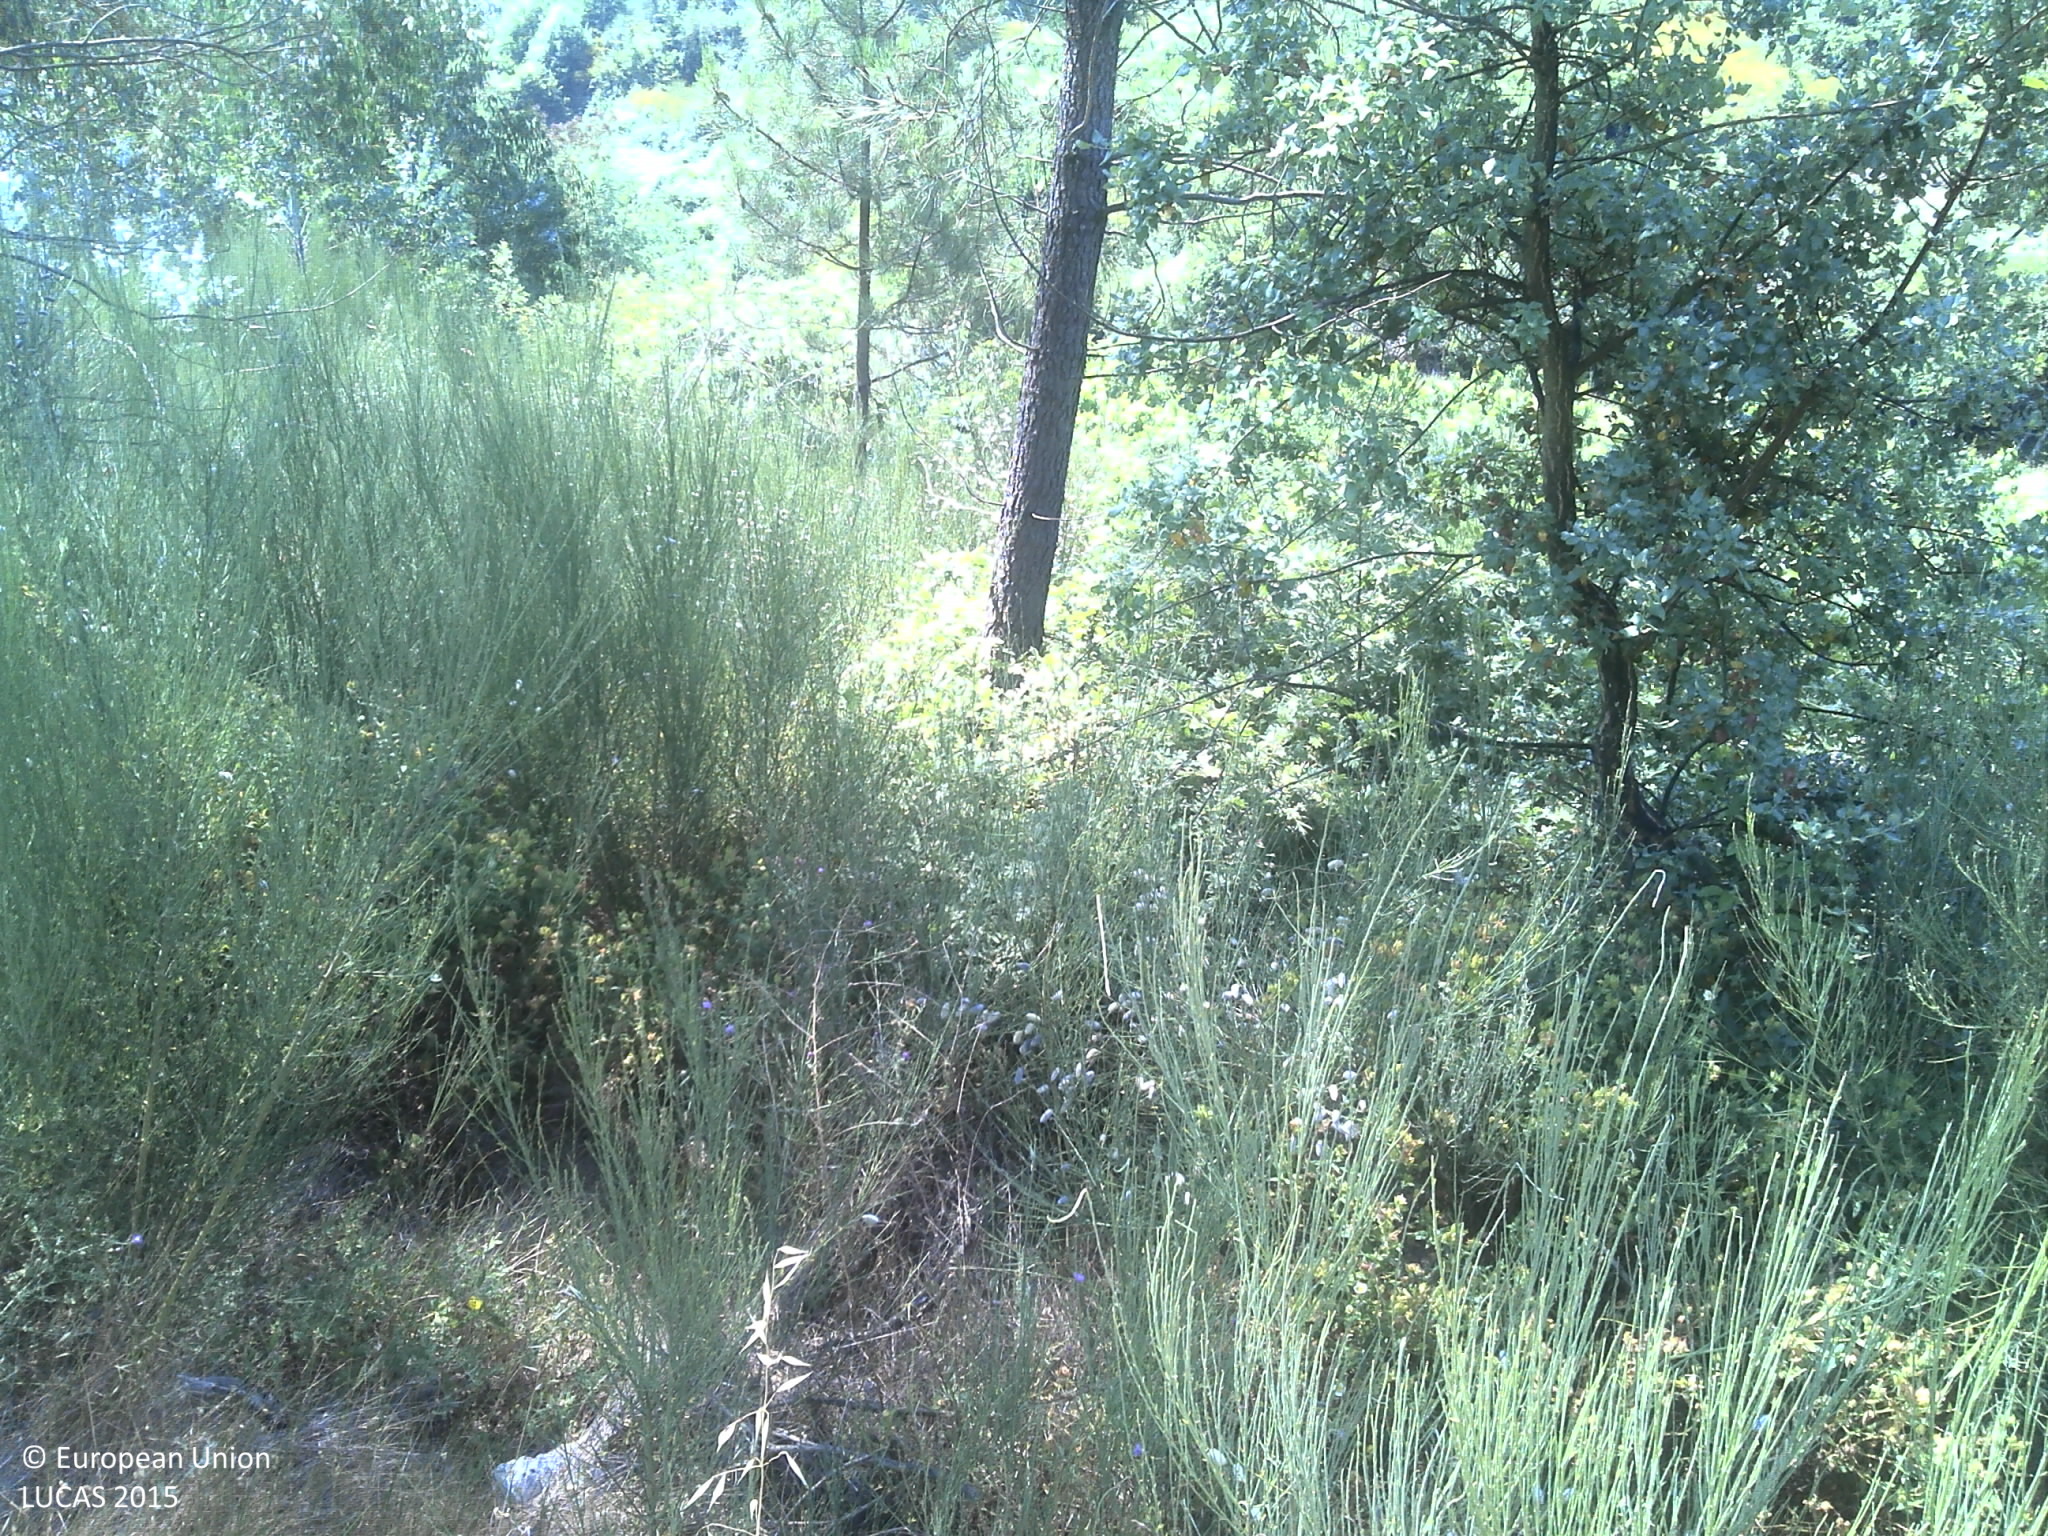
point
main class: Shrubland
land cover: Shrubland without tree cover
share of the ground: > 75 %
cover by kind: shrubs 85 %, herbaceous plants 10 %, unconsolidated bare surface 5 %
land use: Forestry
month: June
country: PT
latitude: 41.1420
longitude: -7.9695
